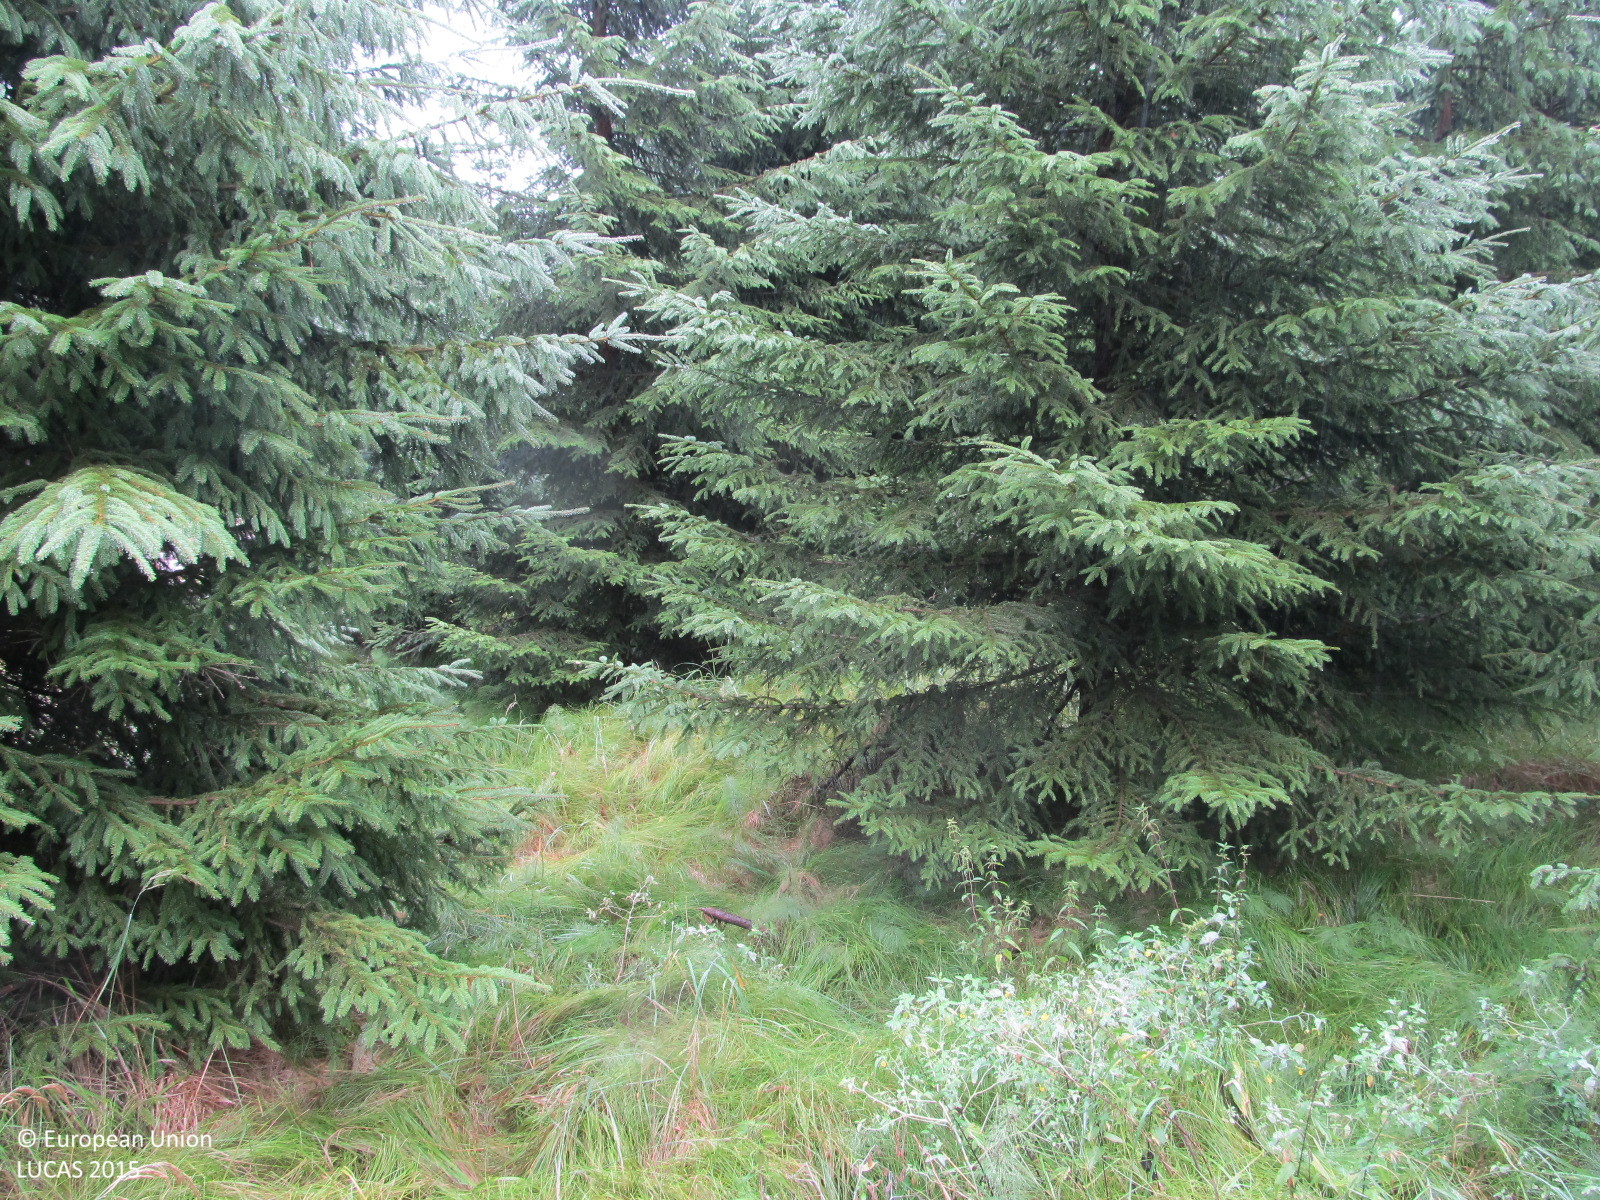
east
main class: Woodland
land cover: Spruce dominated coniferous woodland
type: hemiboreal forest and nemoral coniferous forest and mixed broadleaved-coniferous forest
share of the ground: > 75 %
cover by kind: coniferous forest trees 80 %, herbaceous plants 20 %
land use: Forestry
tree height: > 5 m
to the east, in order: Spruce dominated coniferous woodland; Grassland with sparse tree/shrub cover; Spruce dominated coniferous woodland; Grassland with sparse tree/shrub cover; Spruce dominated coniferous woodland; Grassland with sparse tree/shrub cover; Spruce dominated coniferous woodland
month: August
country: AT
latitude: 48.7006
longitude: 15.0973
